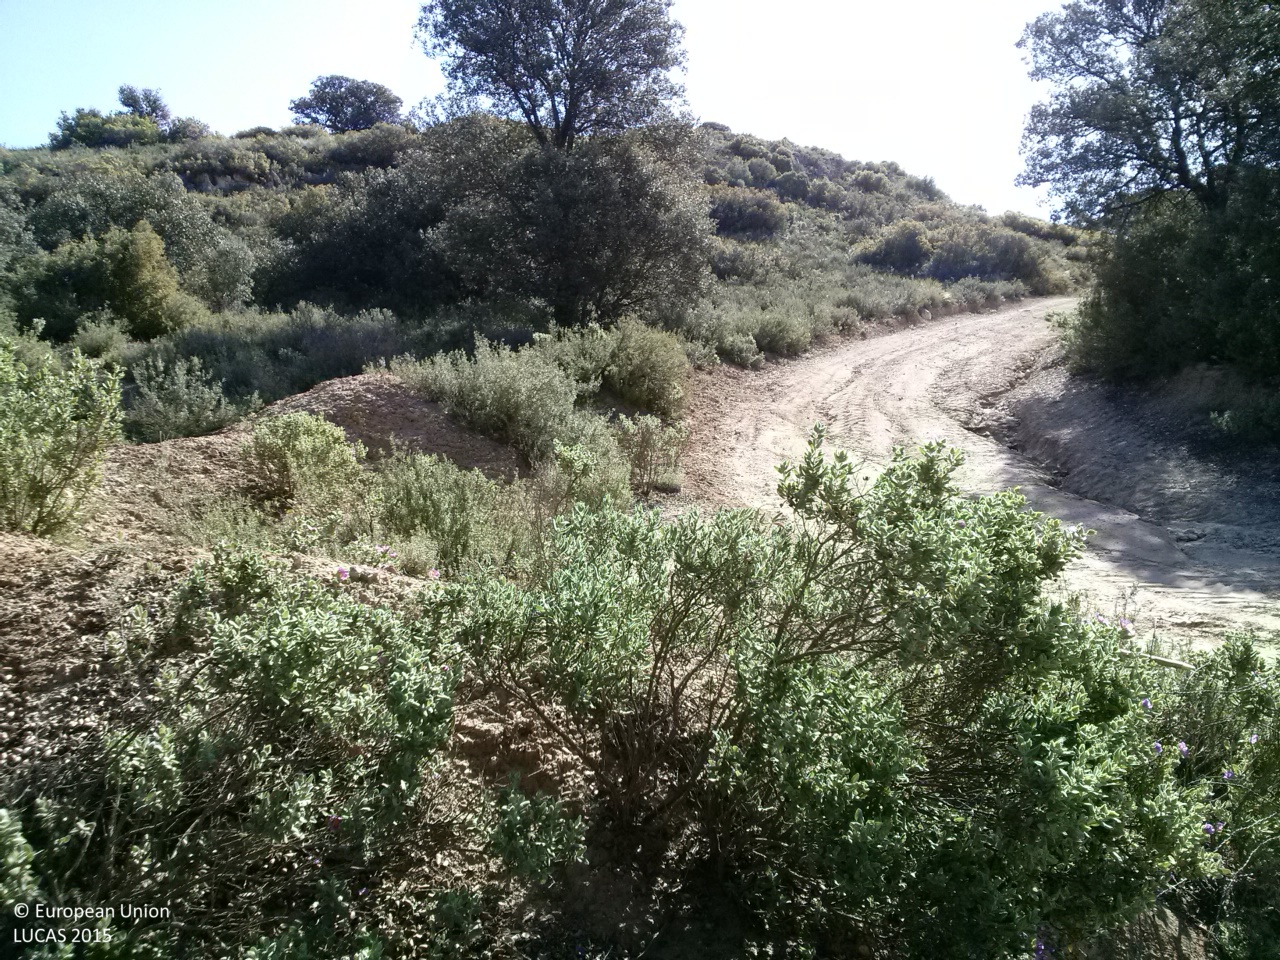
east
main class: Woodland
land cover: Broadleaved woodland
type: broadleaved evergreen forest
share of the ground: 10 - 25 %
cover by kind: shrubs 50 %, broadleaved forest trees 25 %, unconsolidated bare surface 25 %
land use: Forestry
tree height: > 5 m
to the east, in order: Broadleaved woodland
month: May
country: ES
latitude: 39.8676
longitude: -2.7741
